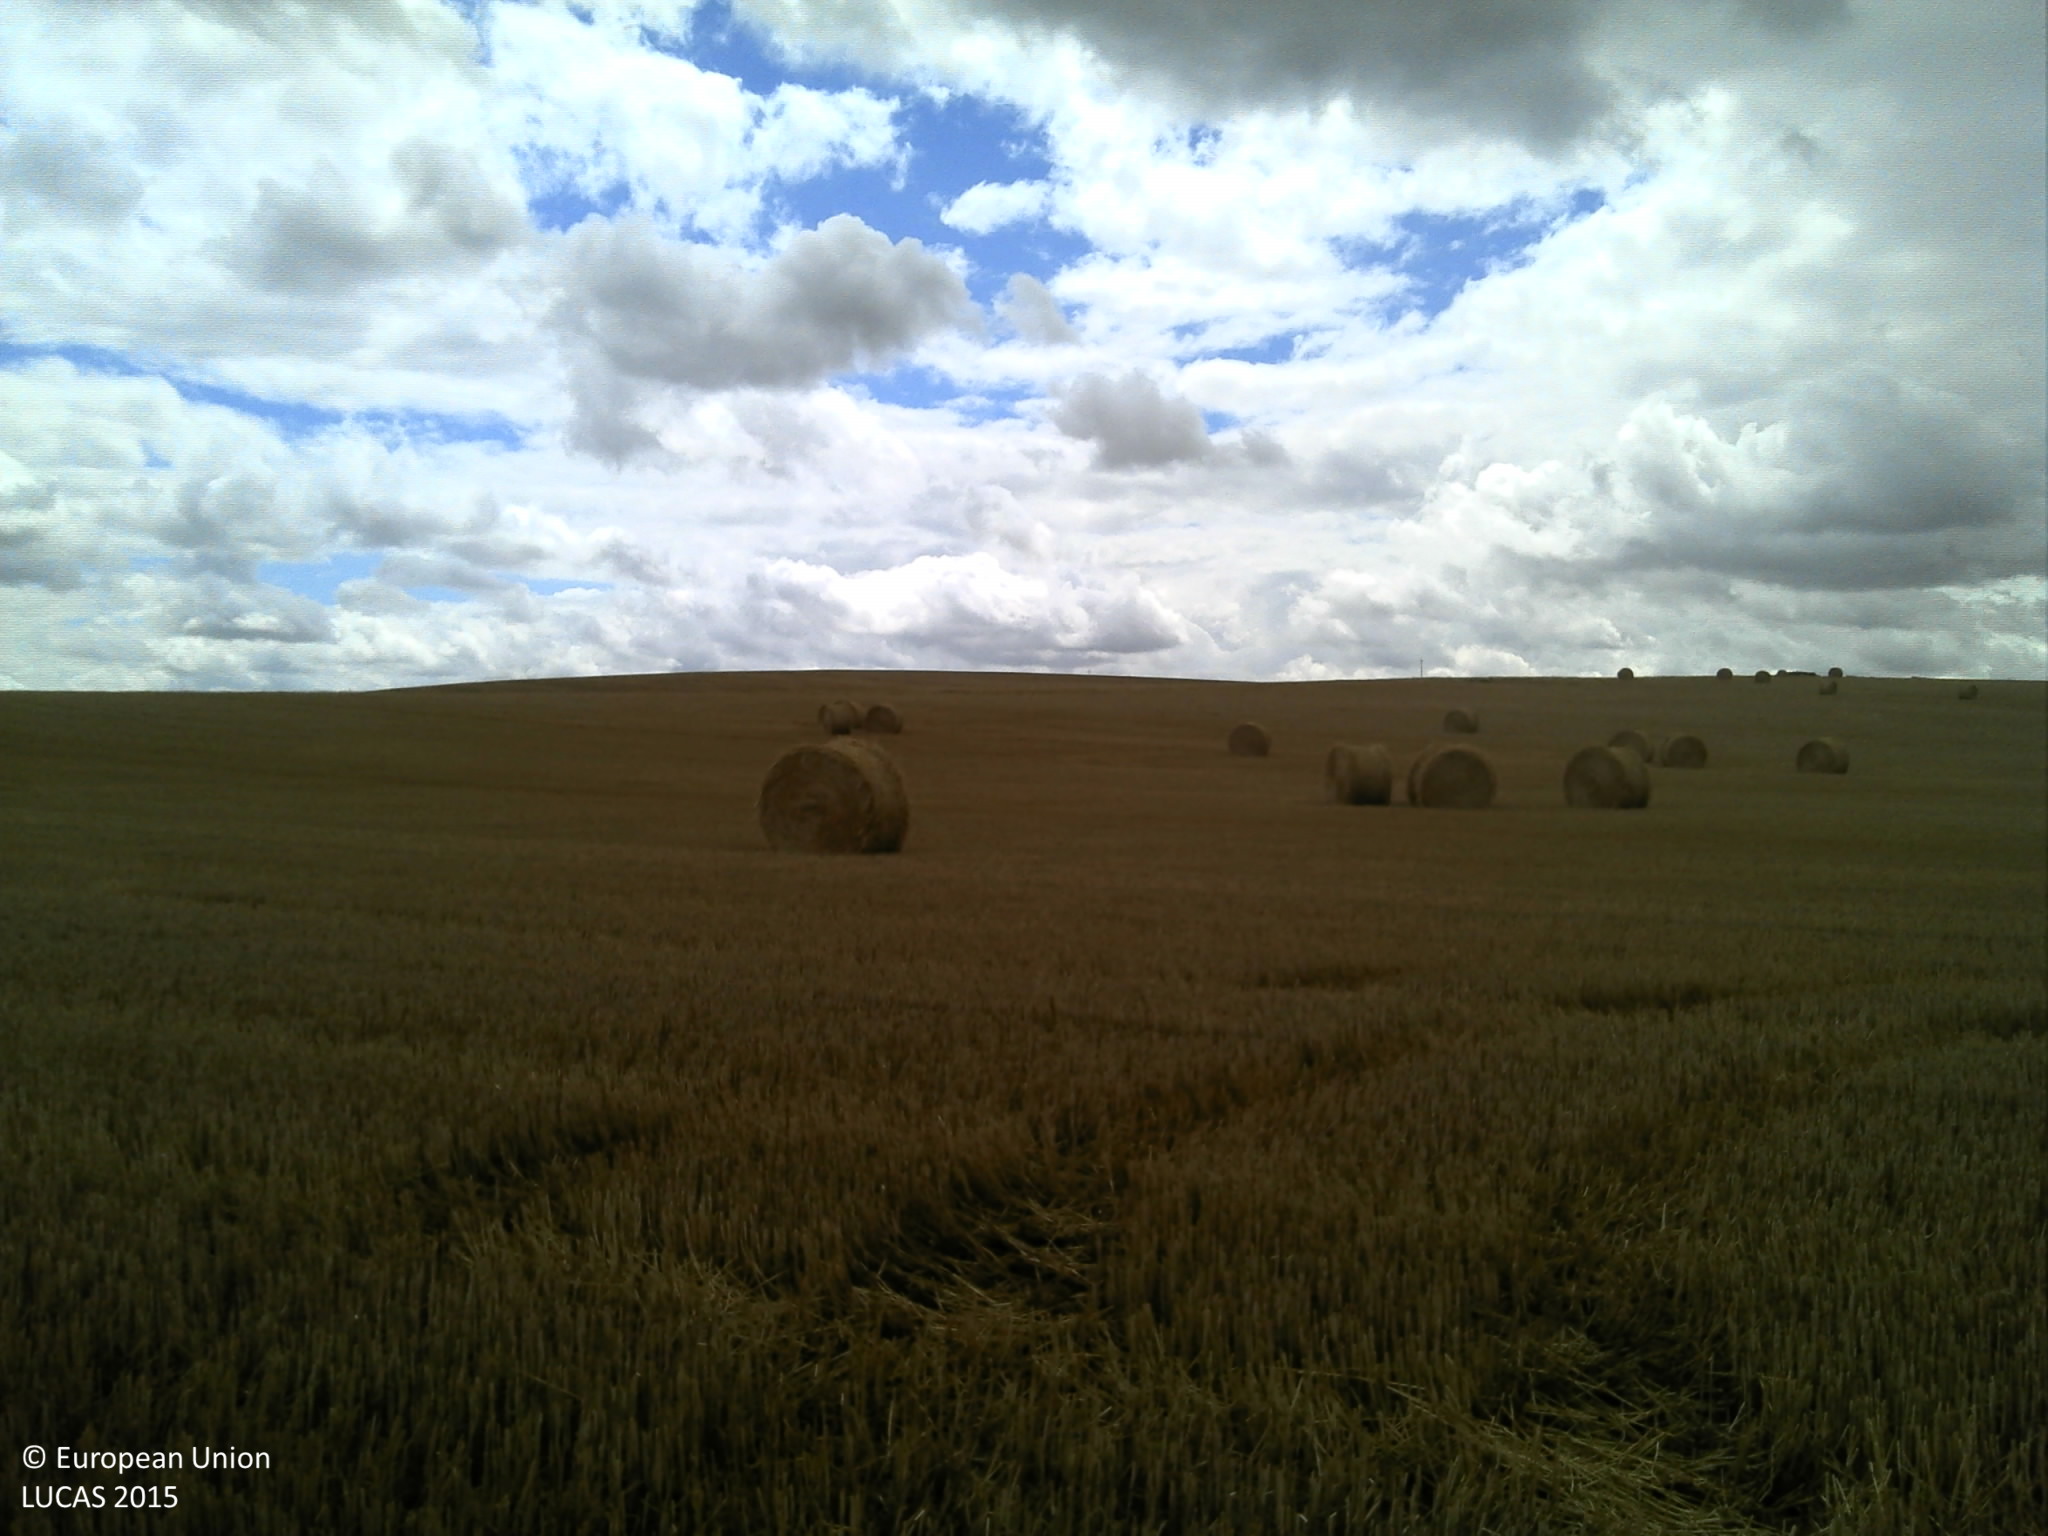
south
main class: Cropland
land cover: Common wheat
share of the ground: 50 - 75 %
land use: Agriculture (excluding fallow land and kitchen gardens)
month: July
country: FR
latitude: 49.4809
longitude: 4.6274
